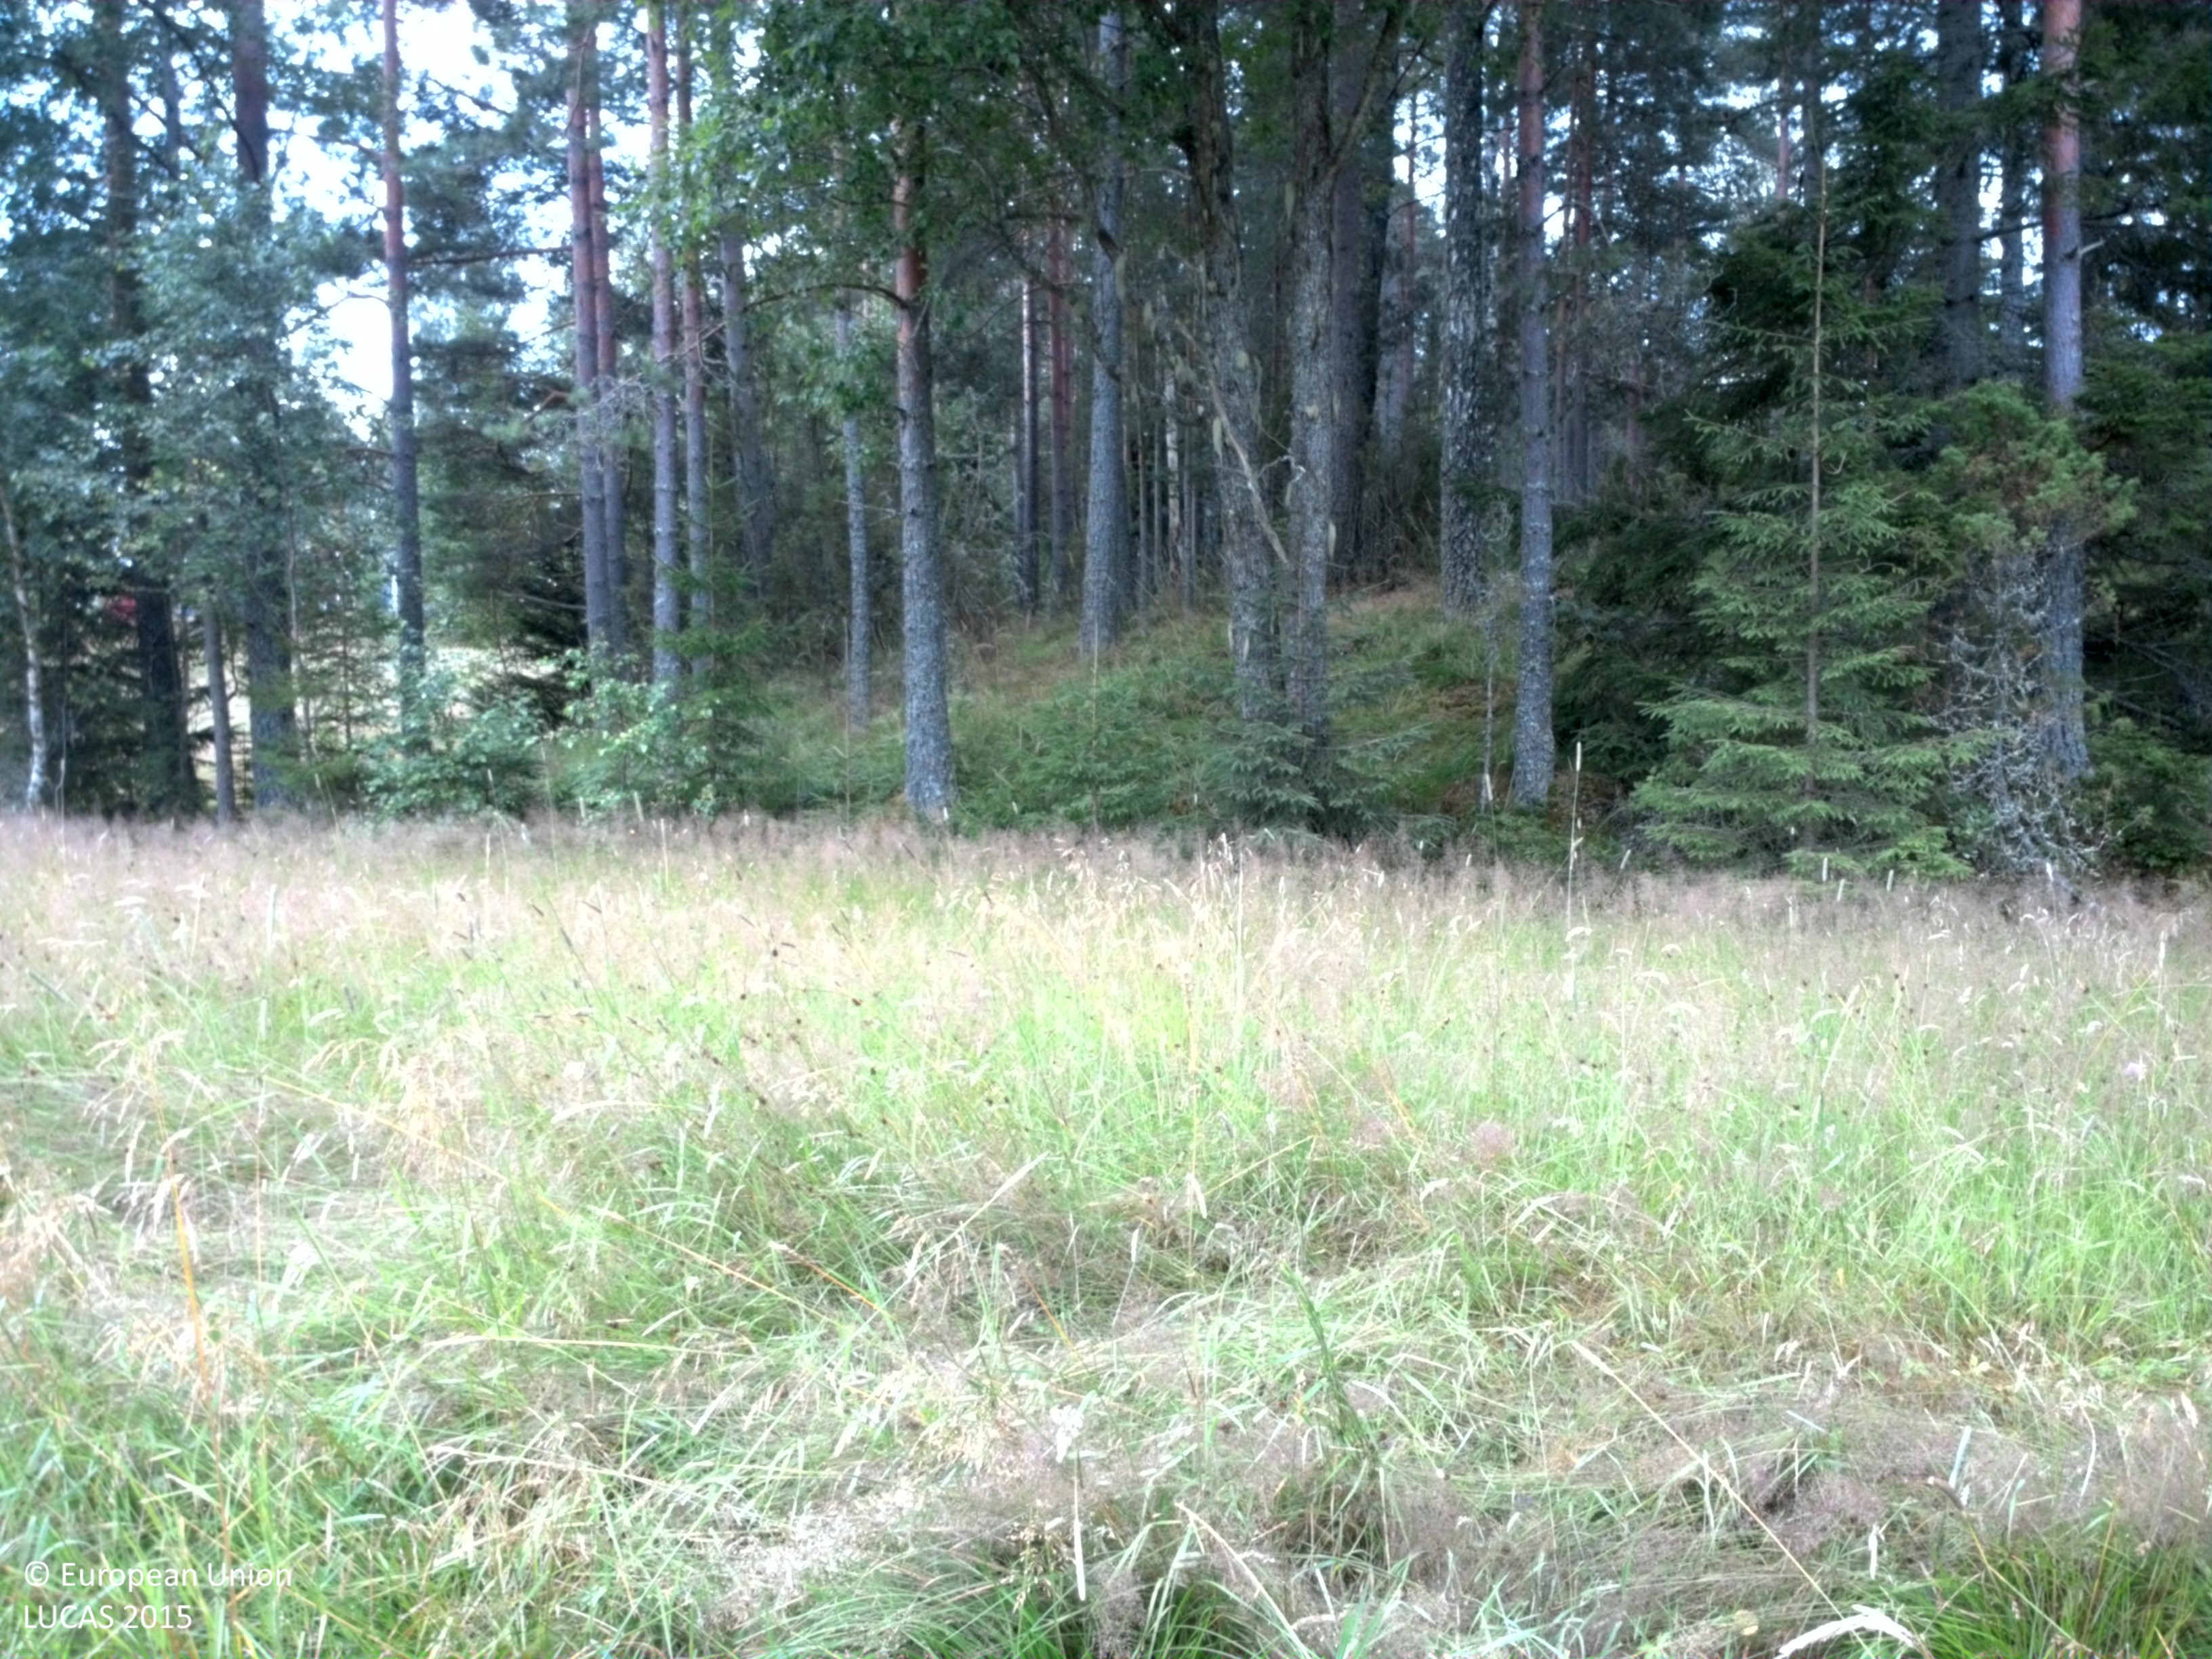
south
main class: Cropland
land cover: Temporary grasslands
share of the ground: > 75 %
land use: Agriculture (excluding fallow land and kitchen gardens)
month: August
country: SE
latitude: 59.3216
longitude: 11.9104
